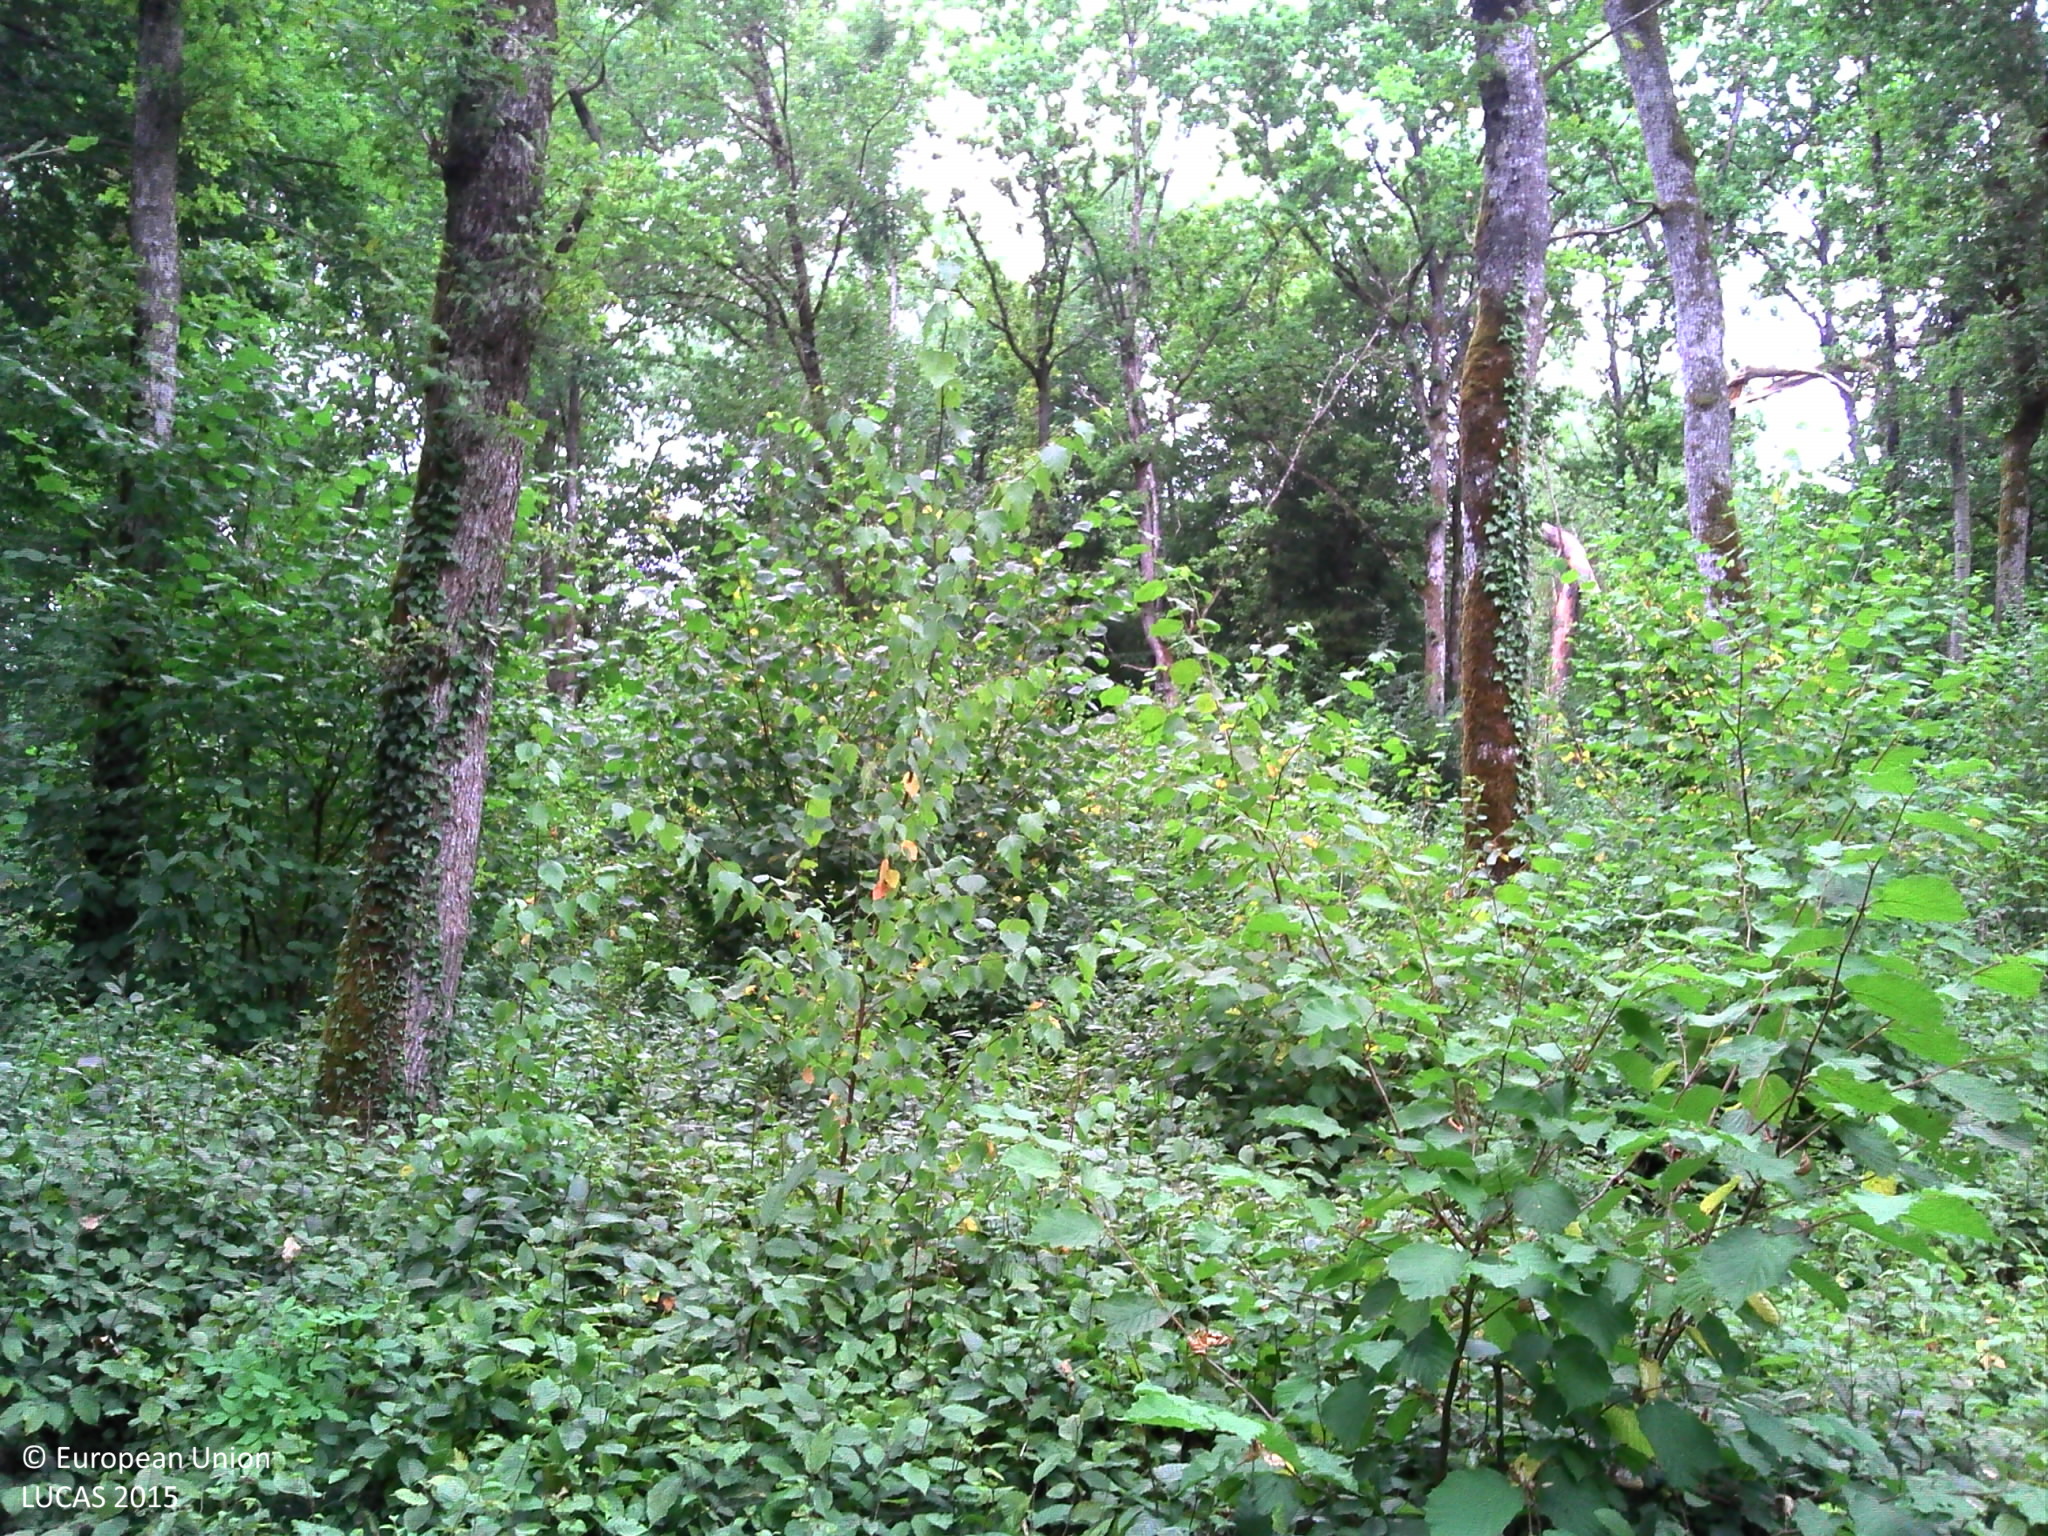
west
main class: Woodland
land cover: Broadleaved woodland
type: mesophytic deciduous forest
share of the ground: > 75 %
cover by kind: broadleaved forest trees 75 %, coniferous forest trees 10 %, herbaceous plants 10 %, lichens and mosses 5 %
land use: Forestry
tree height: > 5 m
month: July
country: FR
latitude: 47.9217
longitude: 5.2222
